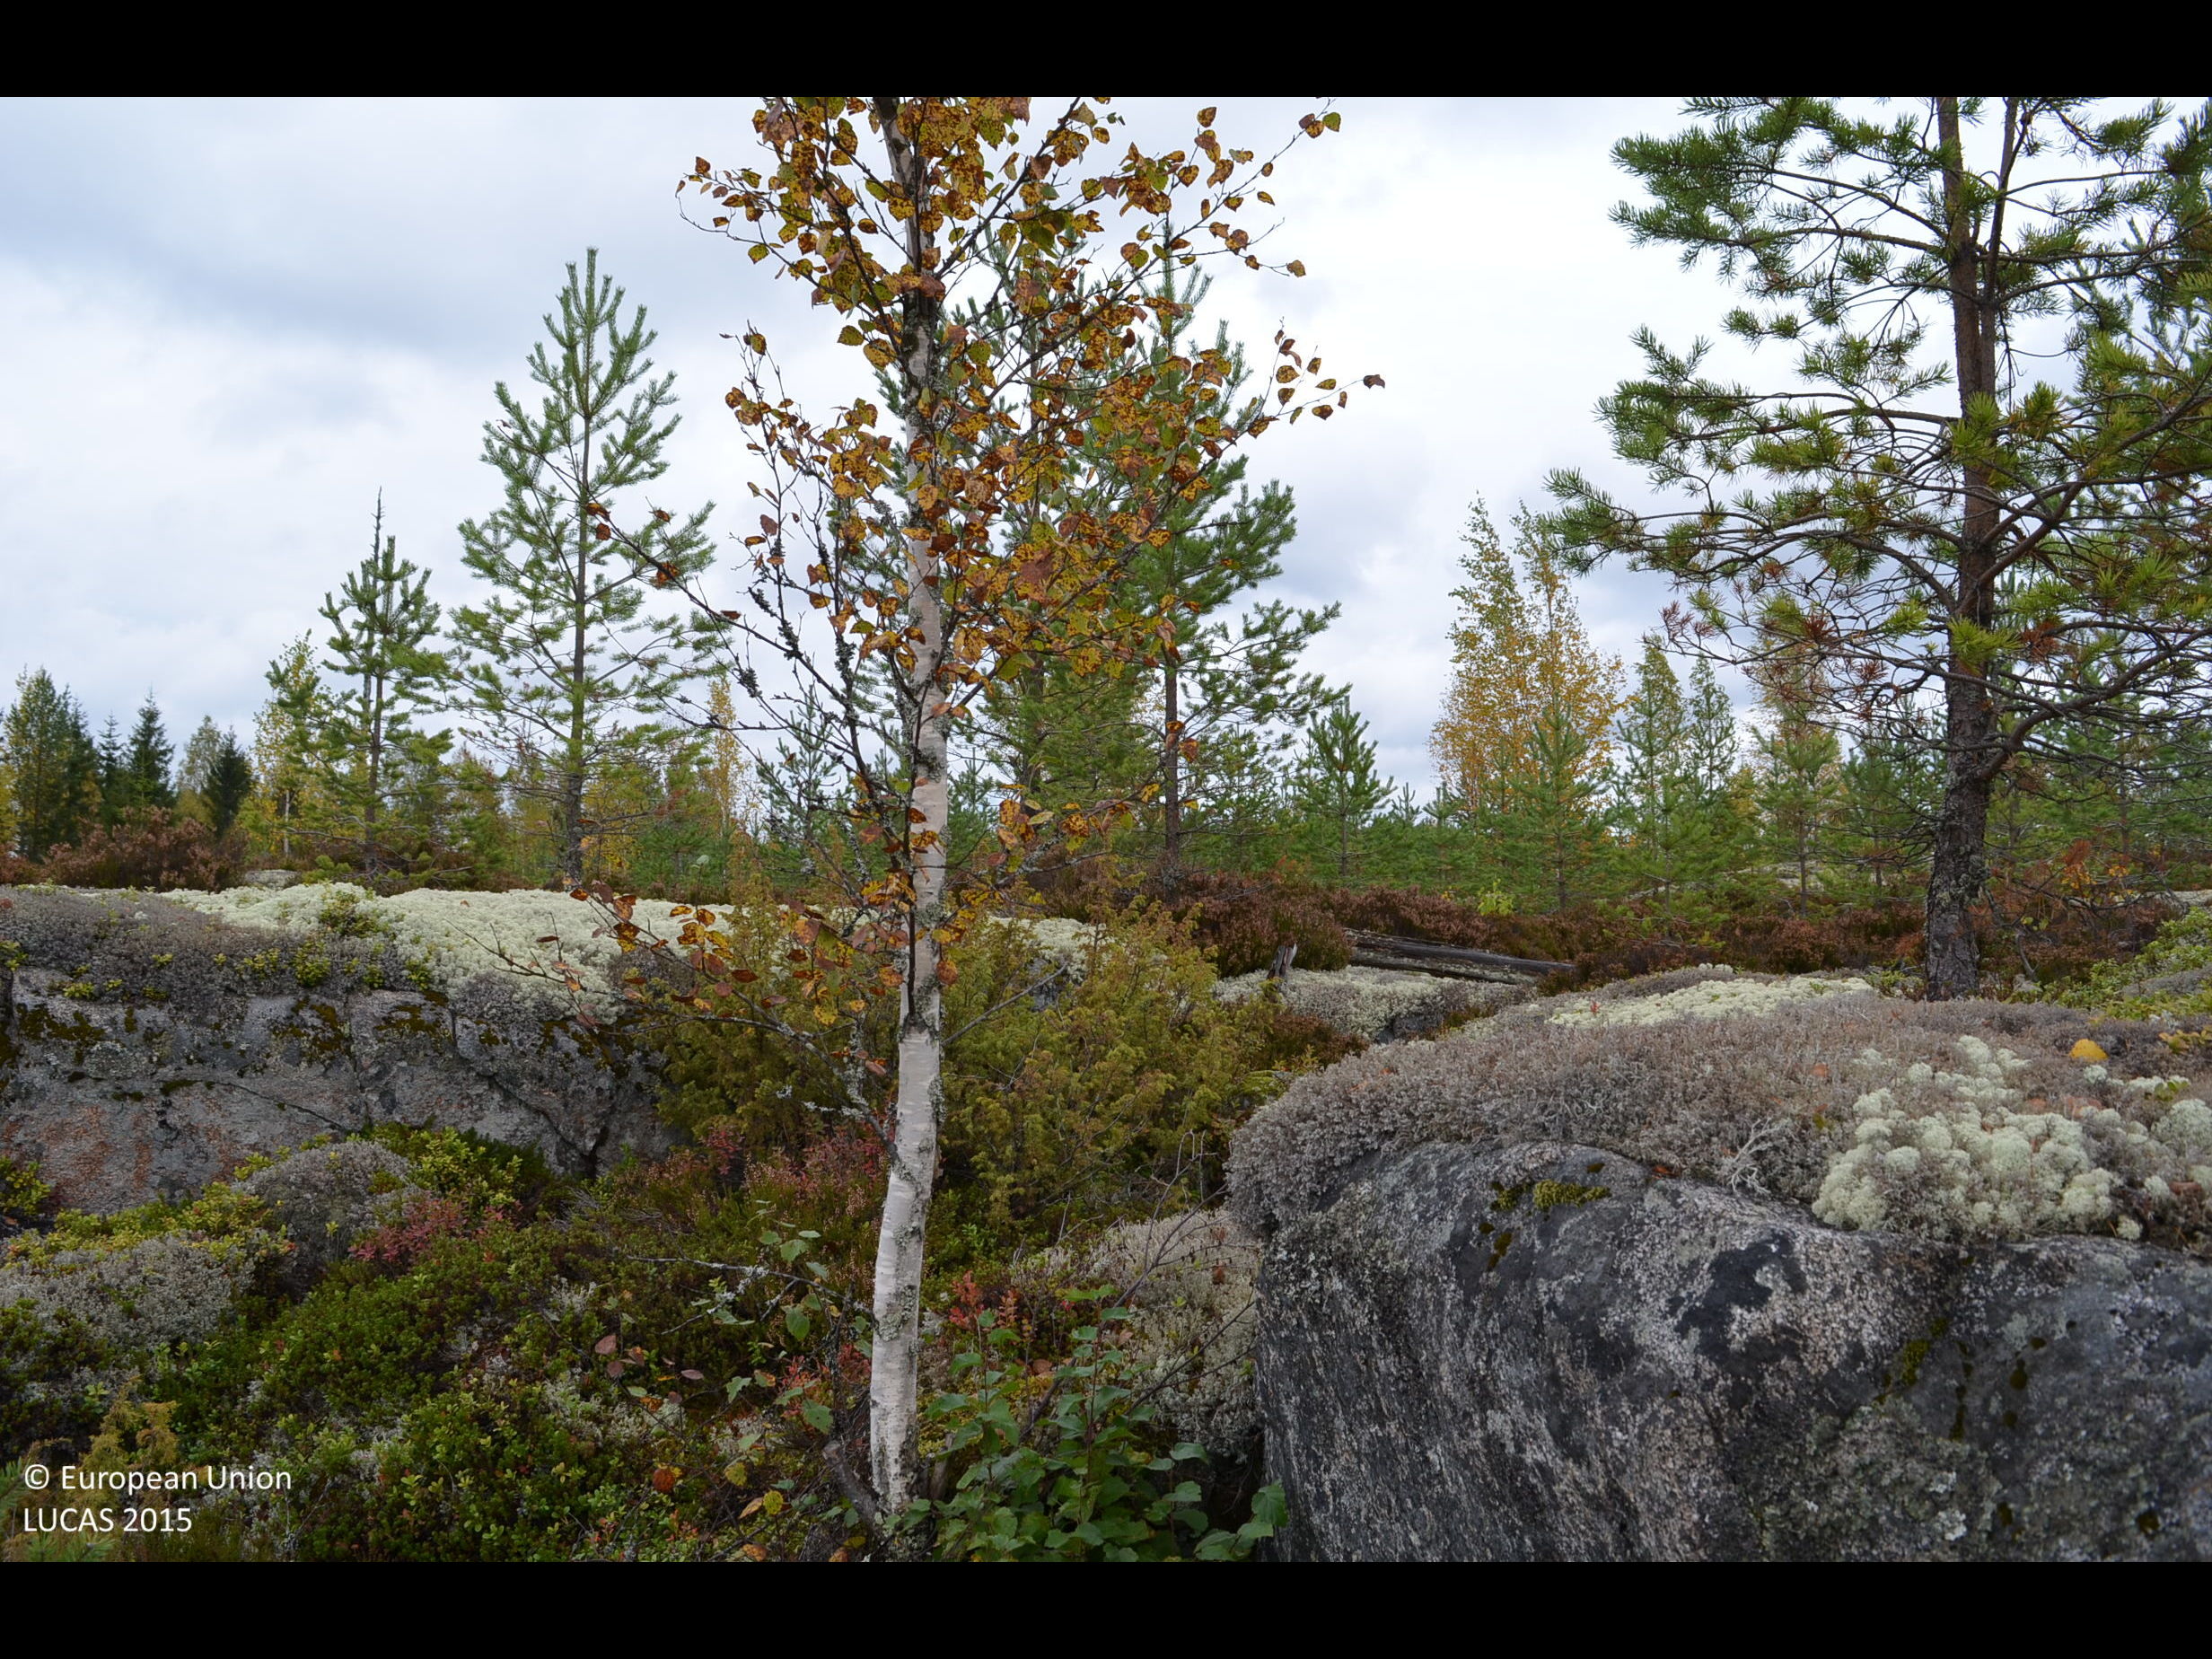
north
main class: Woodland
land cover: Pine dominated mixed woodland
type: boreal forest
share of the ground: 25 - 50 %
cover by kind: coniferous forest trees 30 %, shrubs 20 %, lichens and mosses 20 %, broadleaved forest trees 15 %, unconsolidated bare surface 15 %
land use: Forestry
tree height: < 5 m
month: September
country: FI
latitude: 62.7198
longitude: 23.8628
